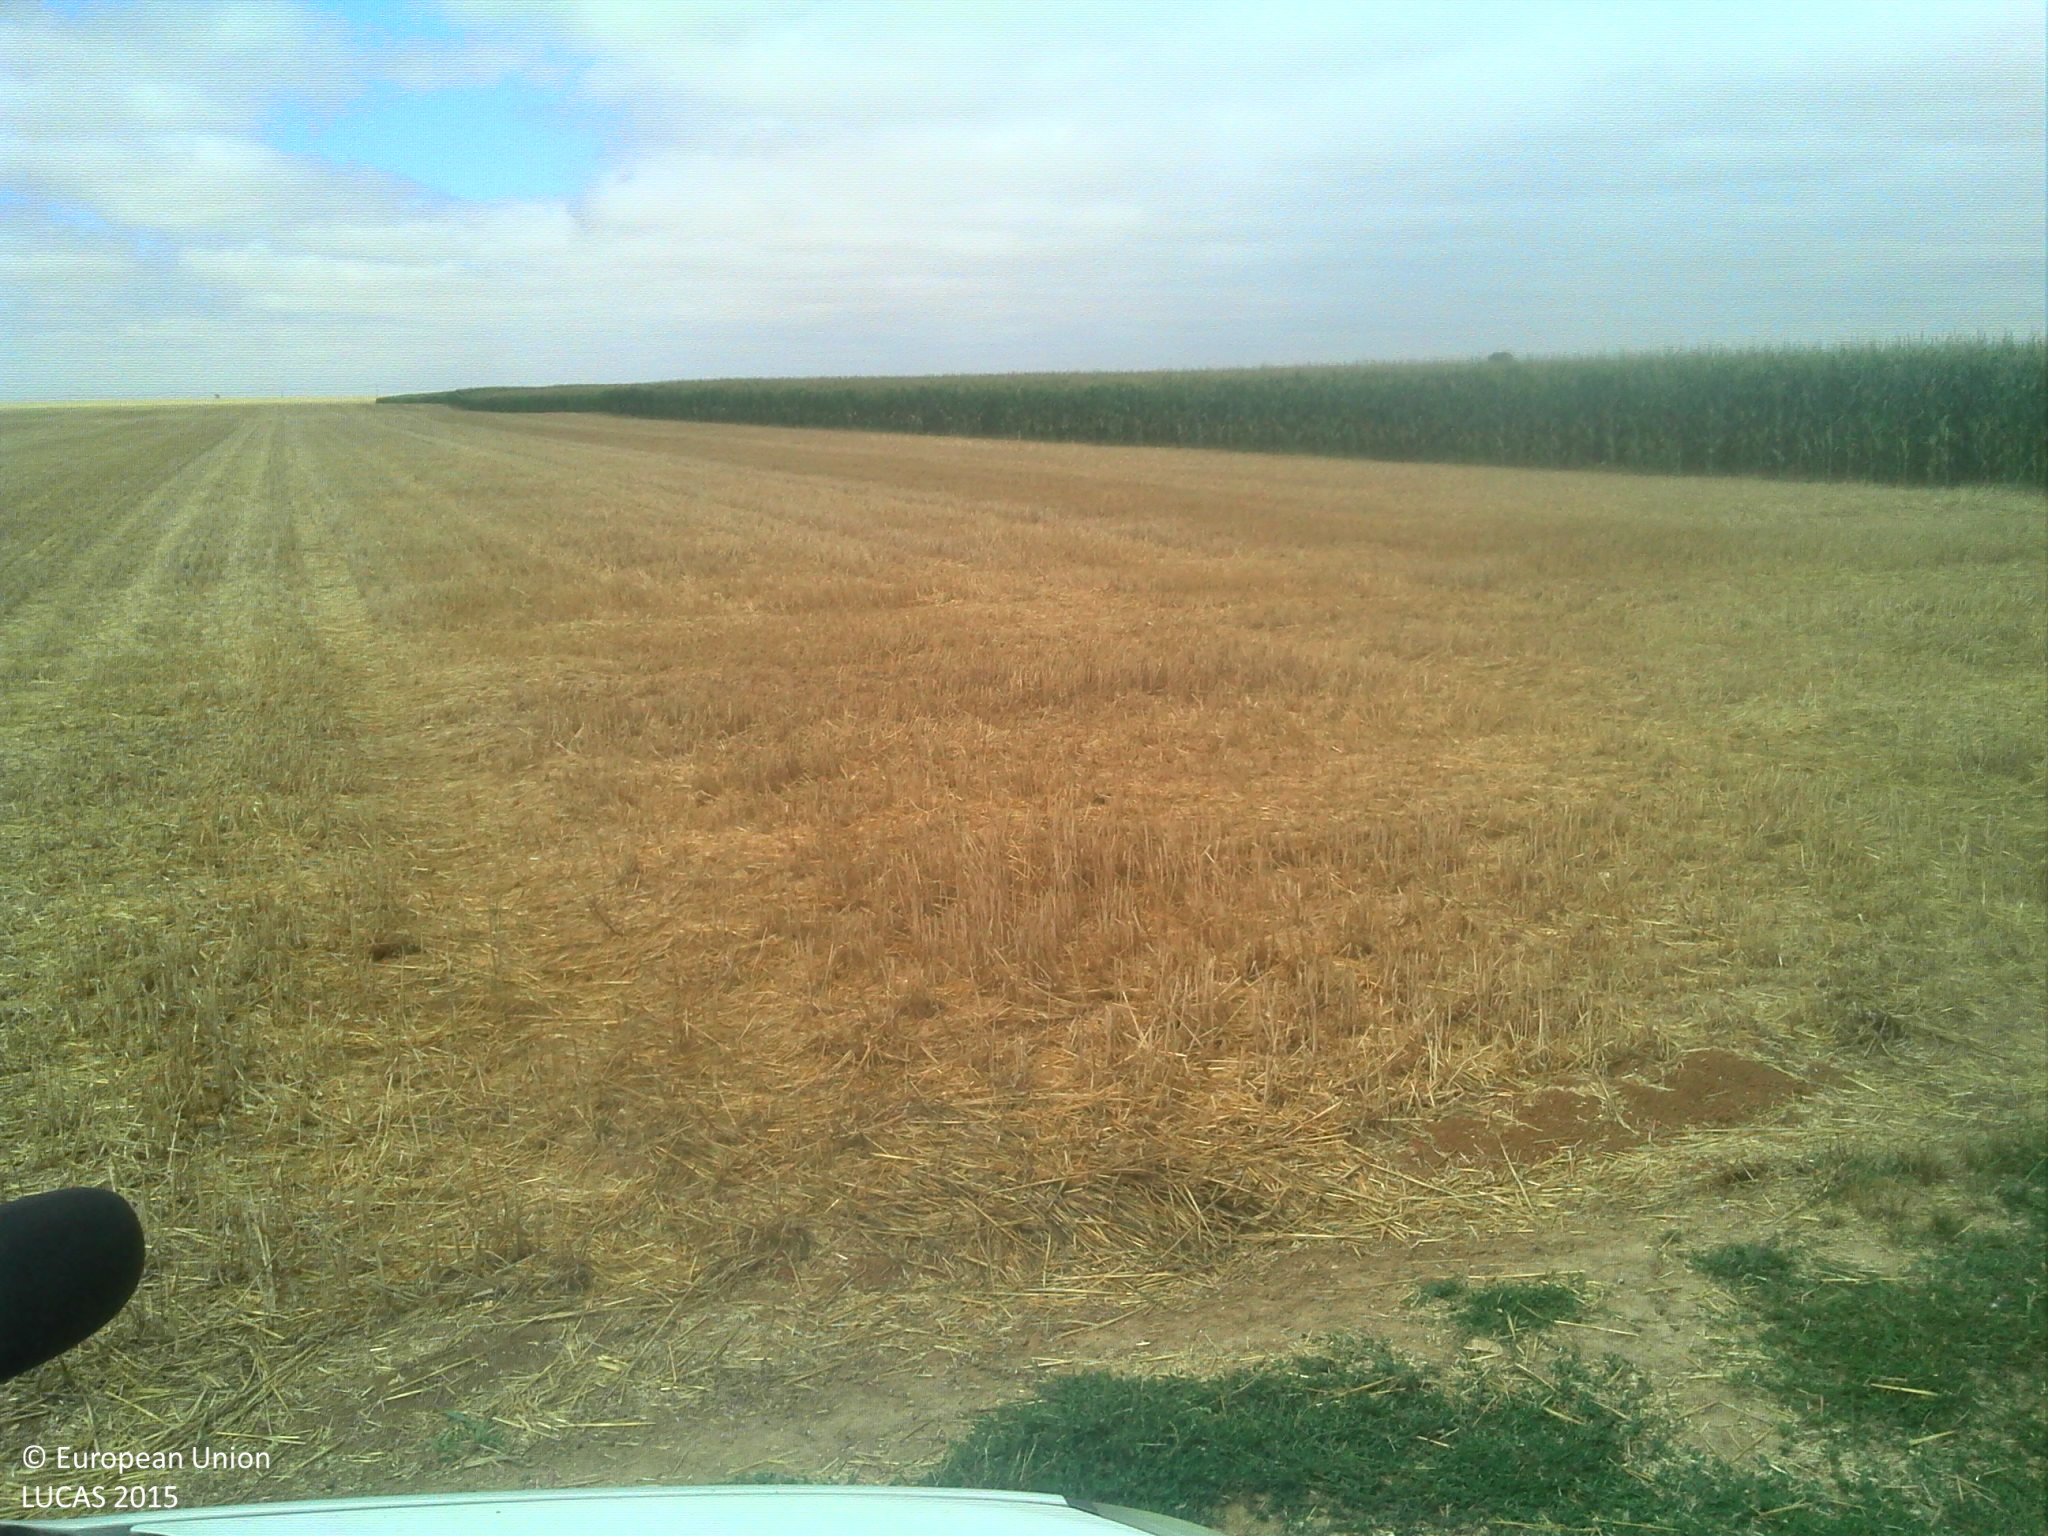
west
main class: Cropland
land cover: Durum wheat
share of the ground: > 75 %
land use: Agriculture (excluding fallow land and kitchen gardens)
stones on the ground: < 10 %
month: July
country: FR
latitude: 47.8081
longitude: 1.3176
